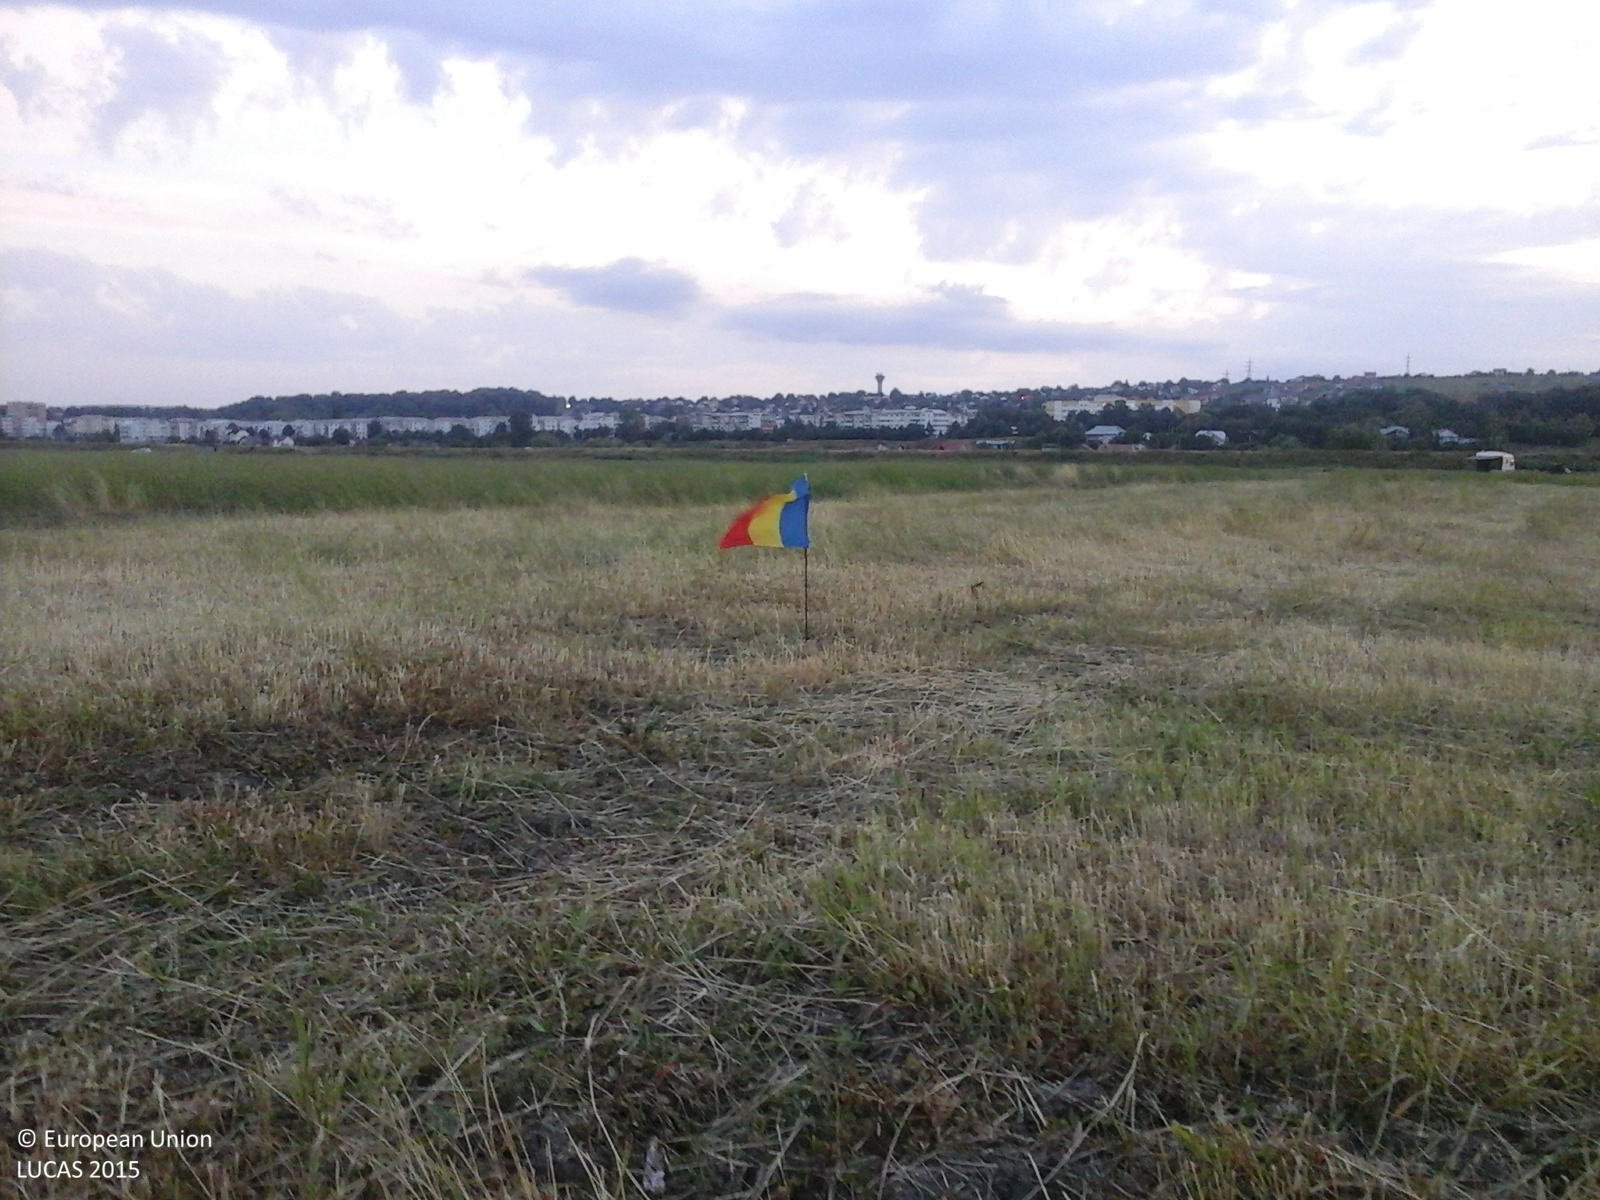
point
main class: Grassland
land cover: Grassland without tree/shrub cover
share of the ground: 10 - 25 %
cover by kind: herbaceous plants 100 %
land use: Agriculture (excluding fallow land and kitchen gardens)
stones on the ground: < 10 %
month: June
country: RO
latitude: 46.6571
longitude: 27.7483
